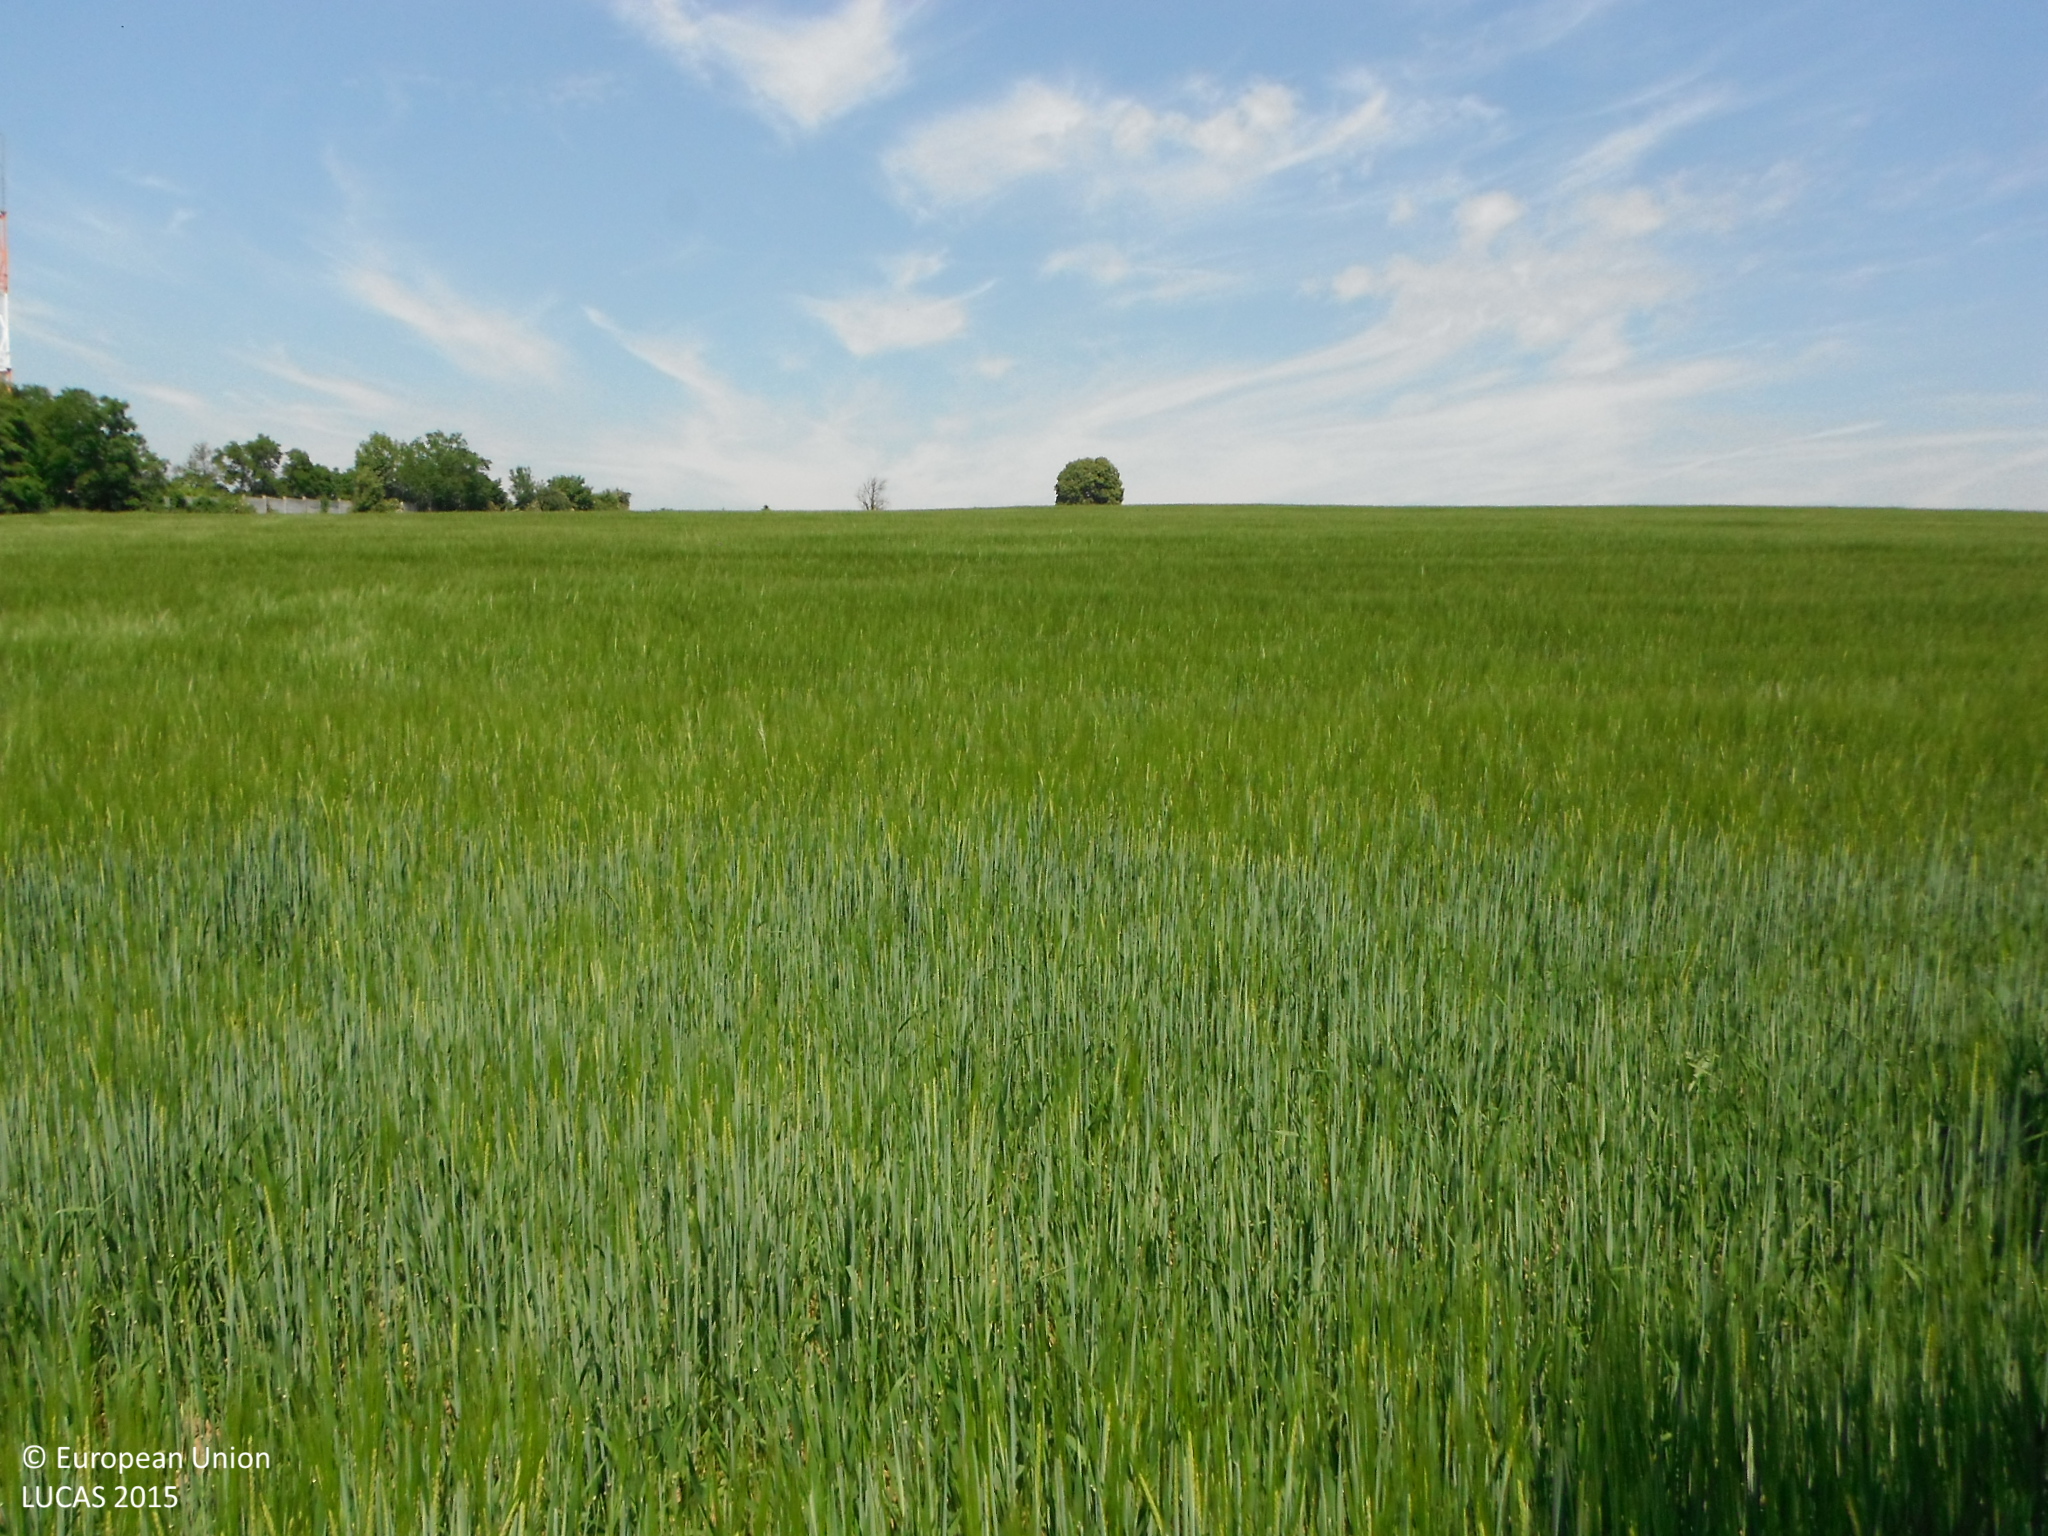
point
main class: Cropland
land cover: Barley
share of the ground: > 75 %
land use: Agriculture (excluding fallow land and kitchen gardens)
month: June
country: SK
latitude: 48.3529
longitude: 17.4185
